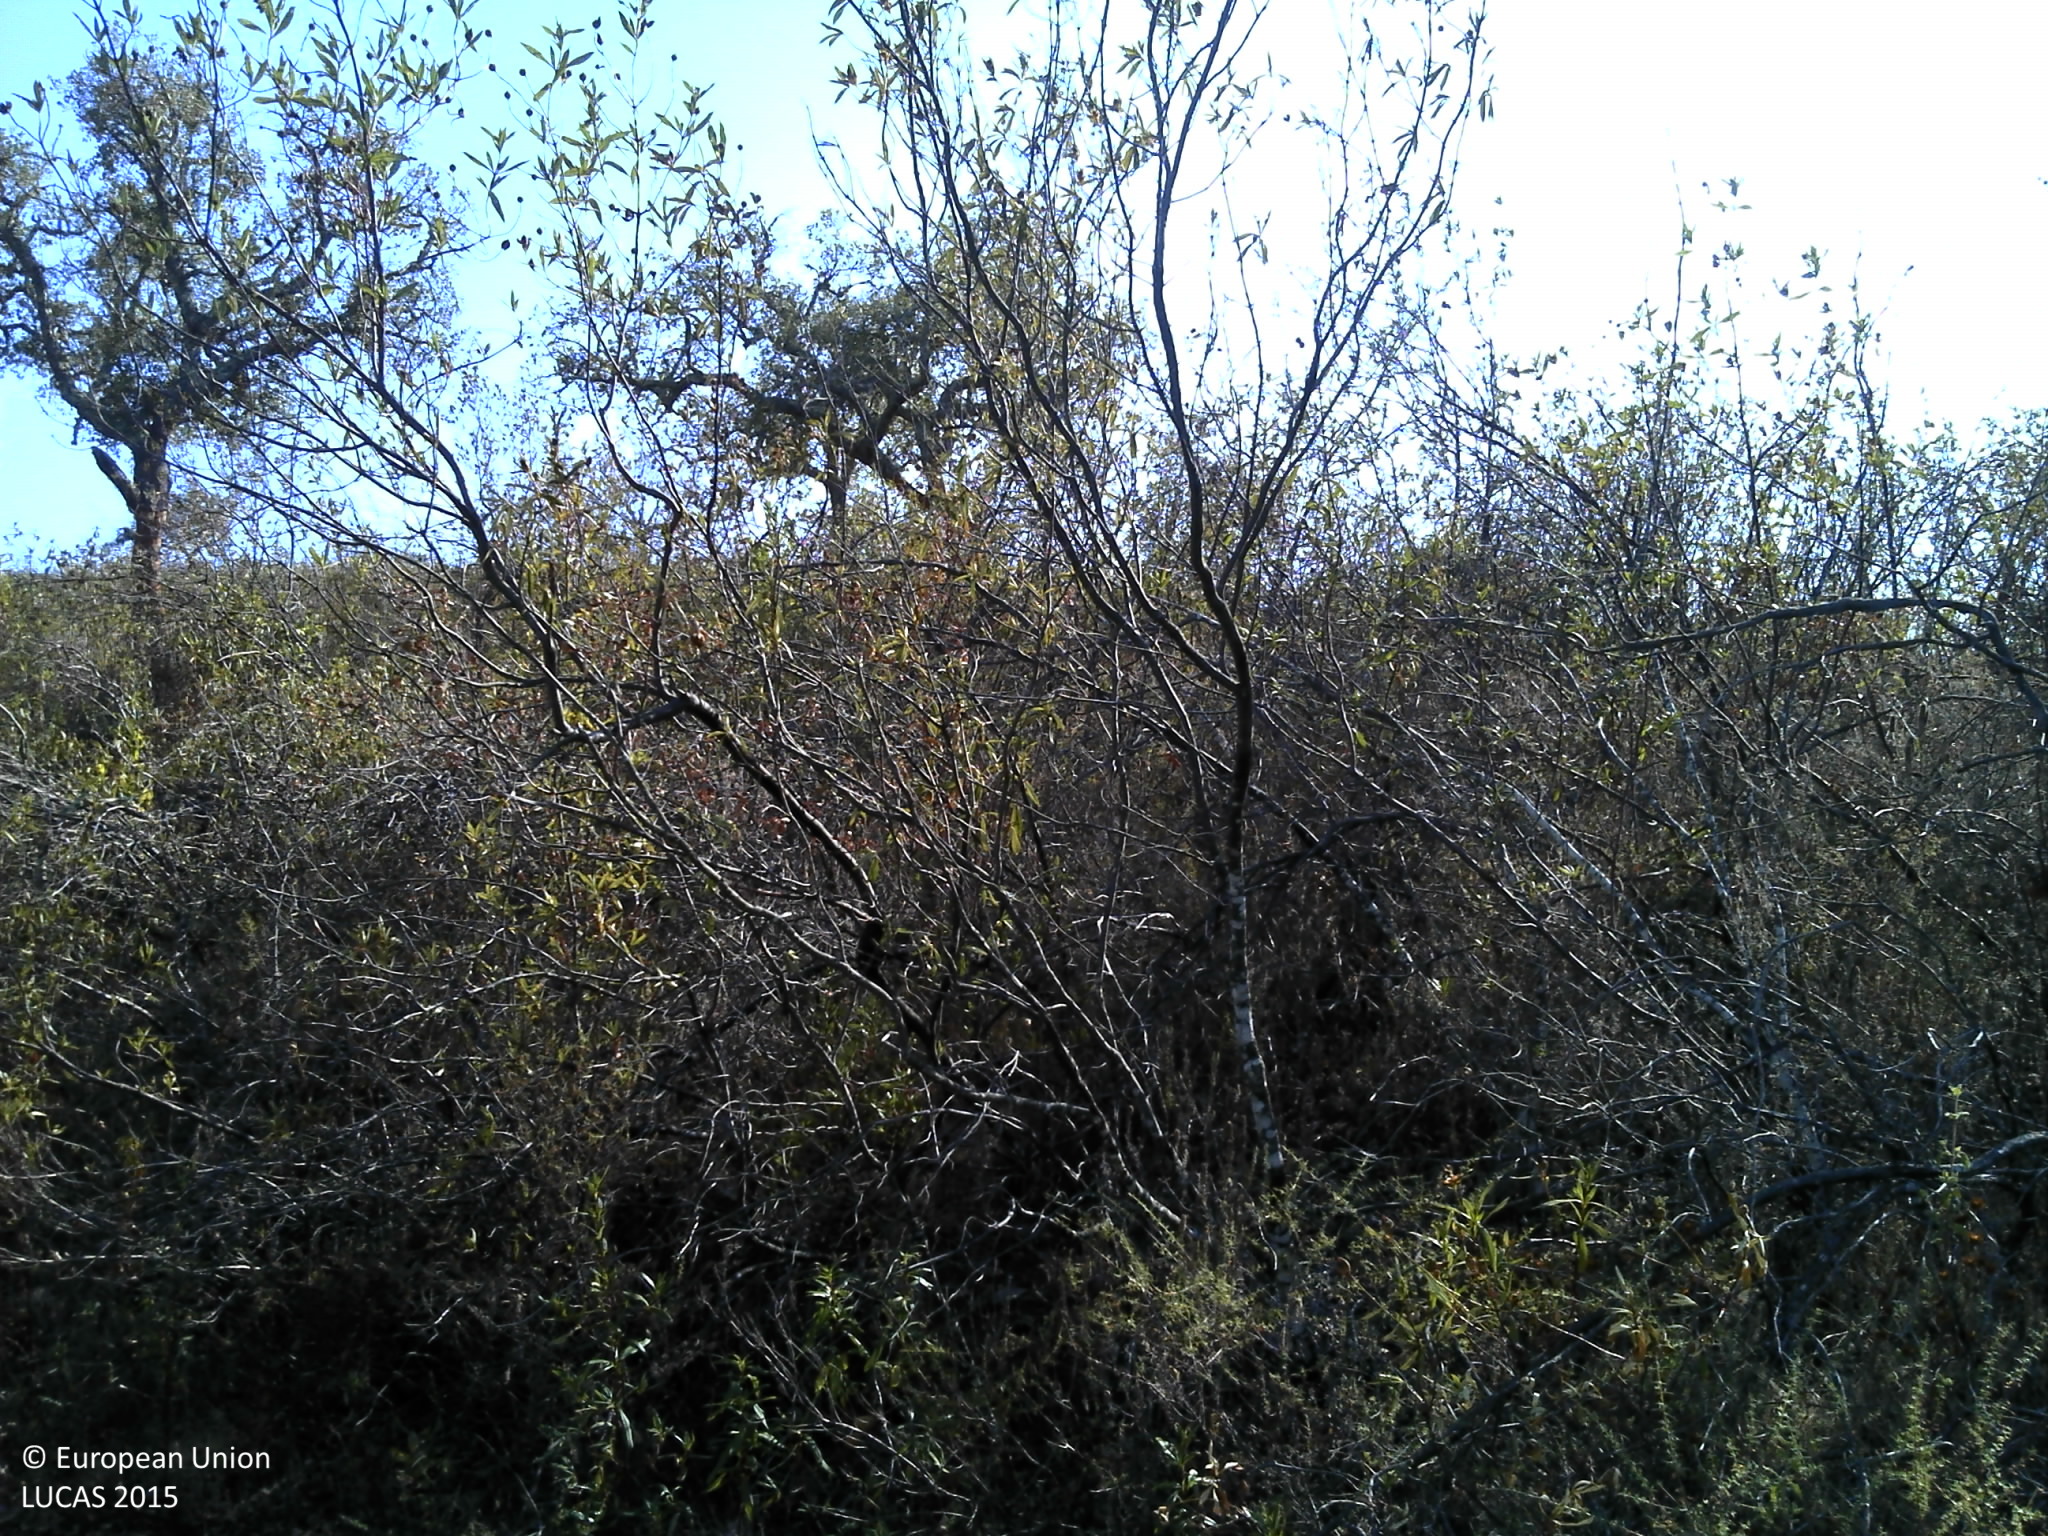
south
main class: Woodland
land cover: Broadleaved woodland
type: broadleaved evergreen forest
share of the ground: 50 - 75 %
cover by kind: broadleaved forest trees 50 %, shrubs 40 %, unconsolidated bare surface 10 %
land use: Forestry
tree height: > 5 m
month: September
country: PT
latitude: 37.4367
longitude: -8.2089
